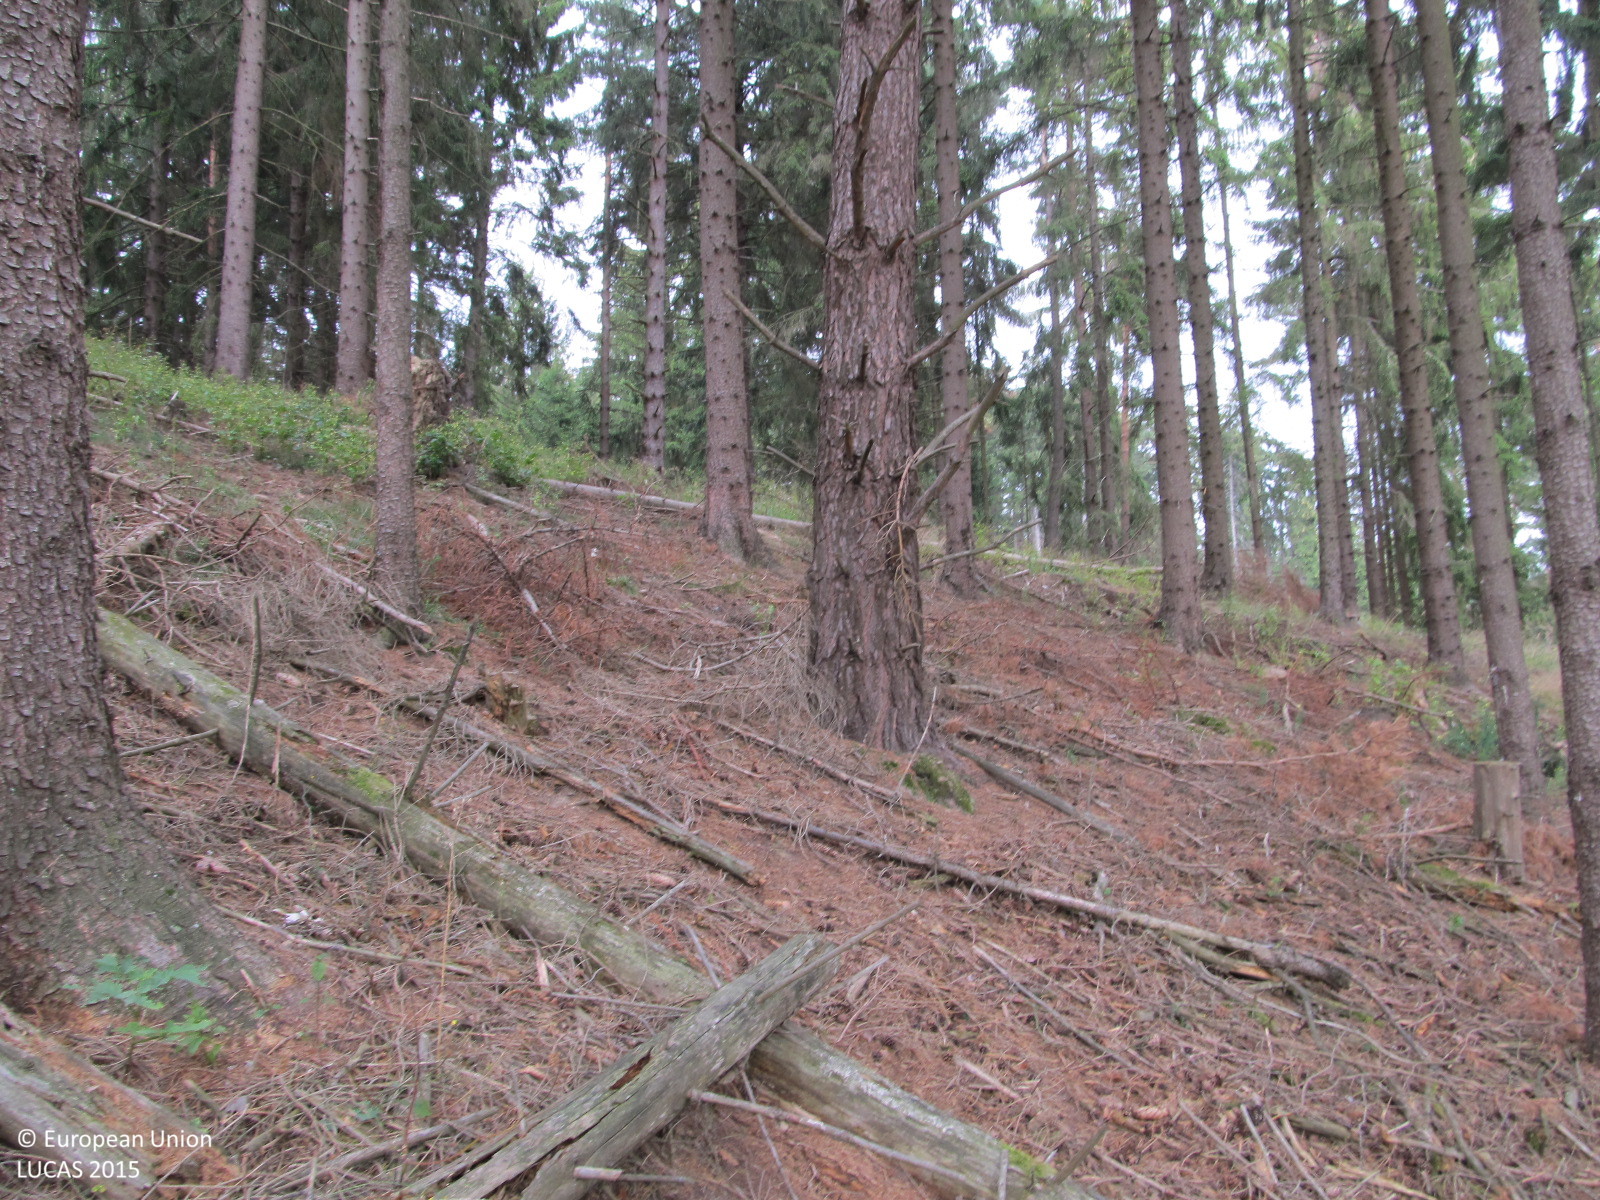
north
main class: Woodland
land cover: Spruce dominated coniferous woodland
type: hemiboreal forest and nemoral coniferous forest and mixed broadleaved-coniferous forest
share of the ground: > 75 %
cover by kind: coniferous forest trees 80 %, unconsolidated bare surface 20 %
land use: Forestry
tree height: > 5 m
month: September
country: AT
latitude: 48.3404
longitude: 15.4665
